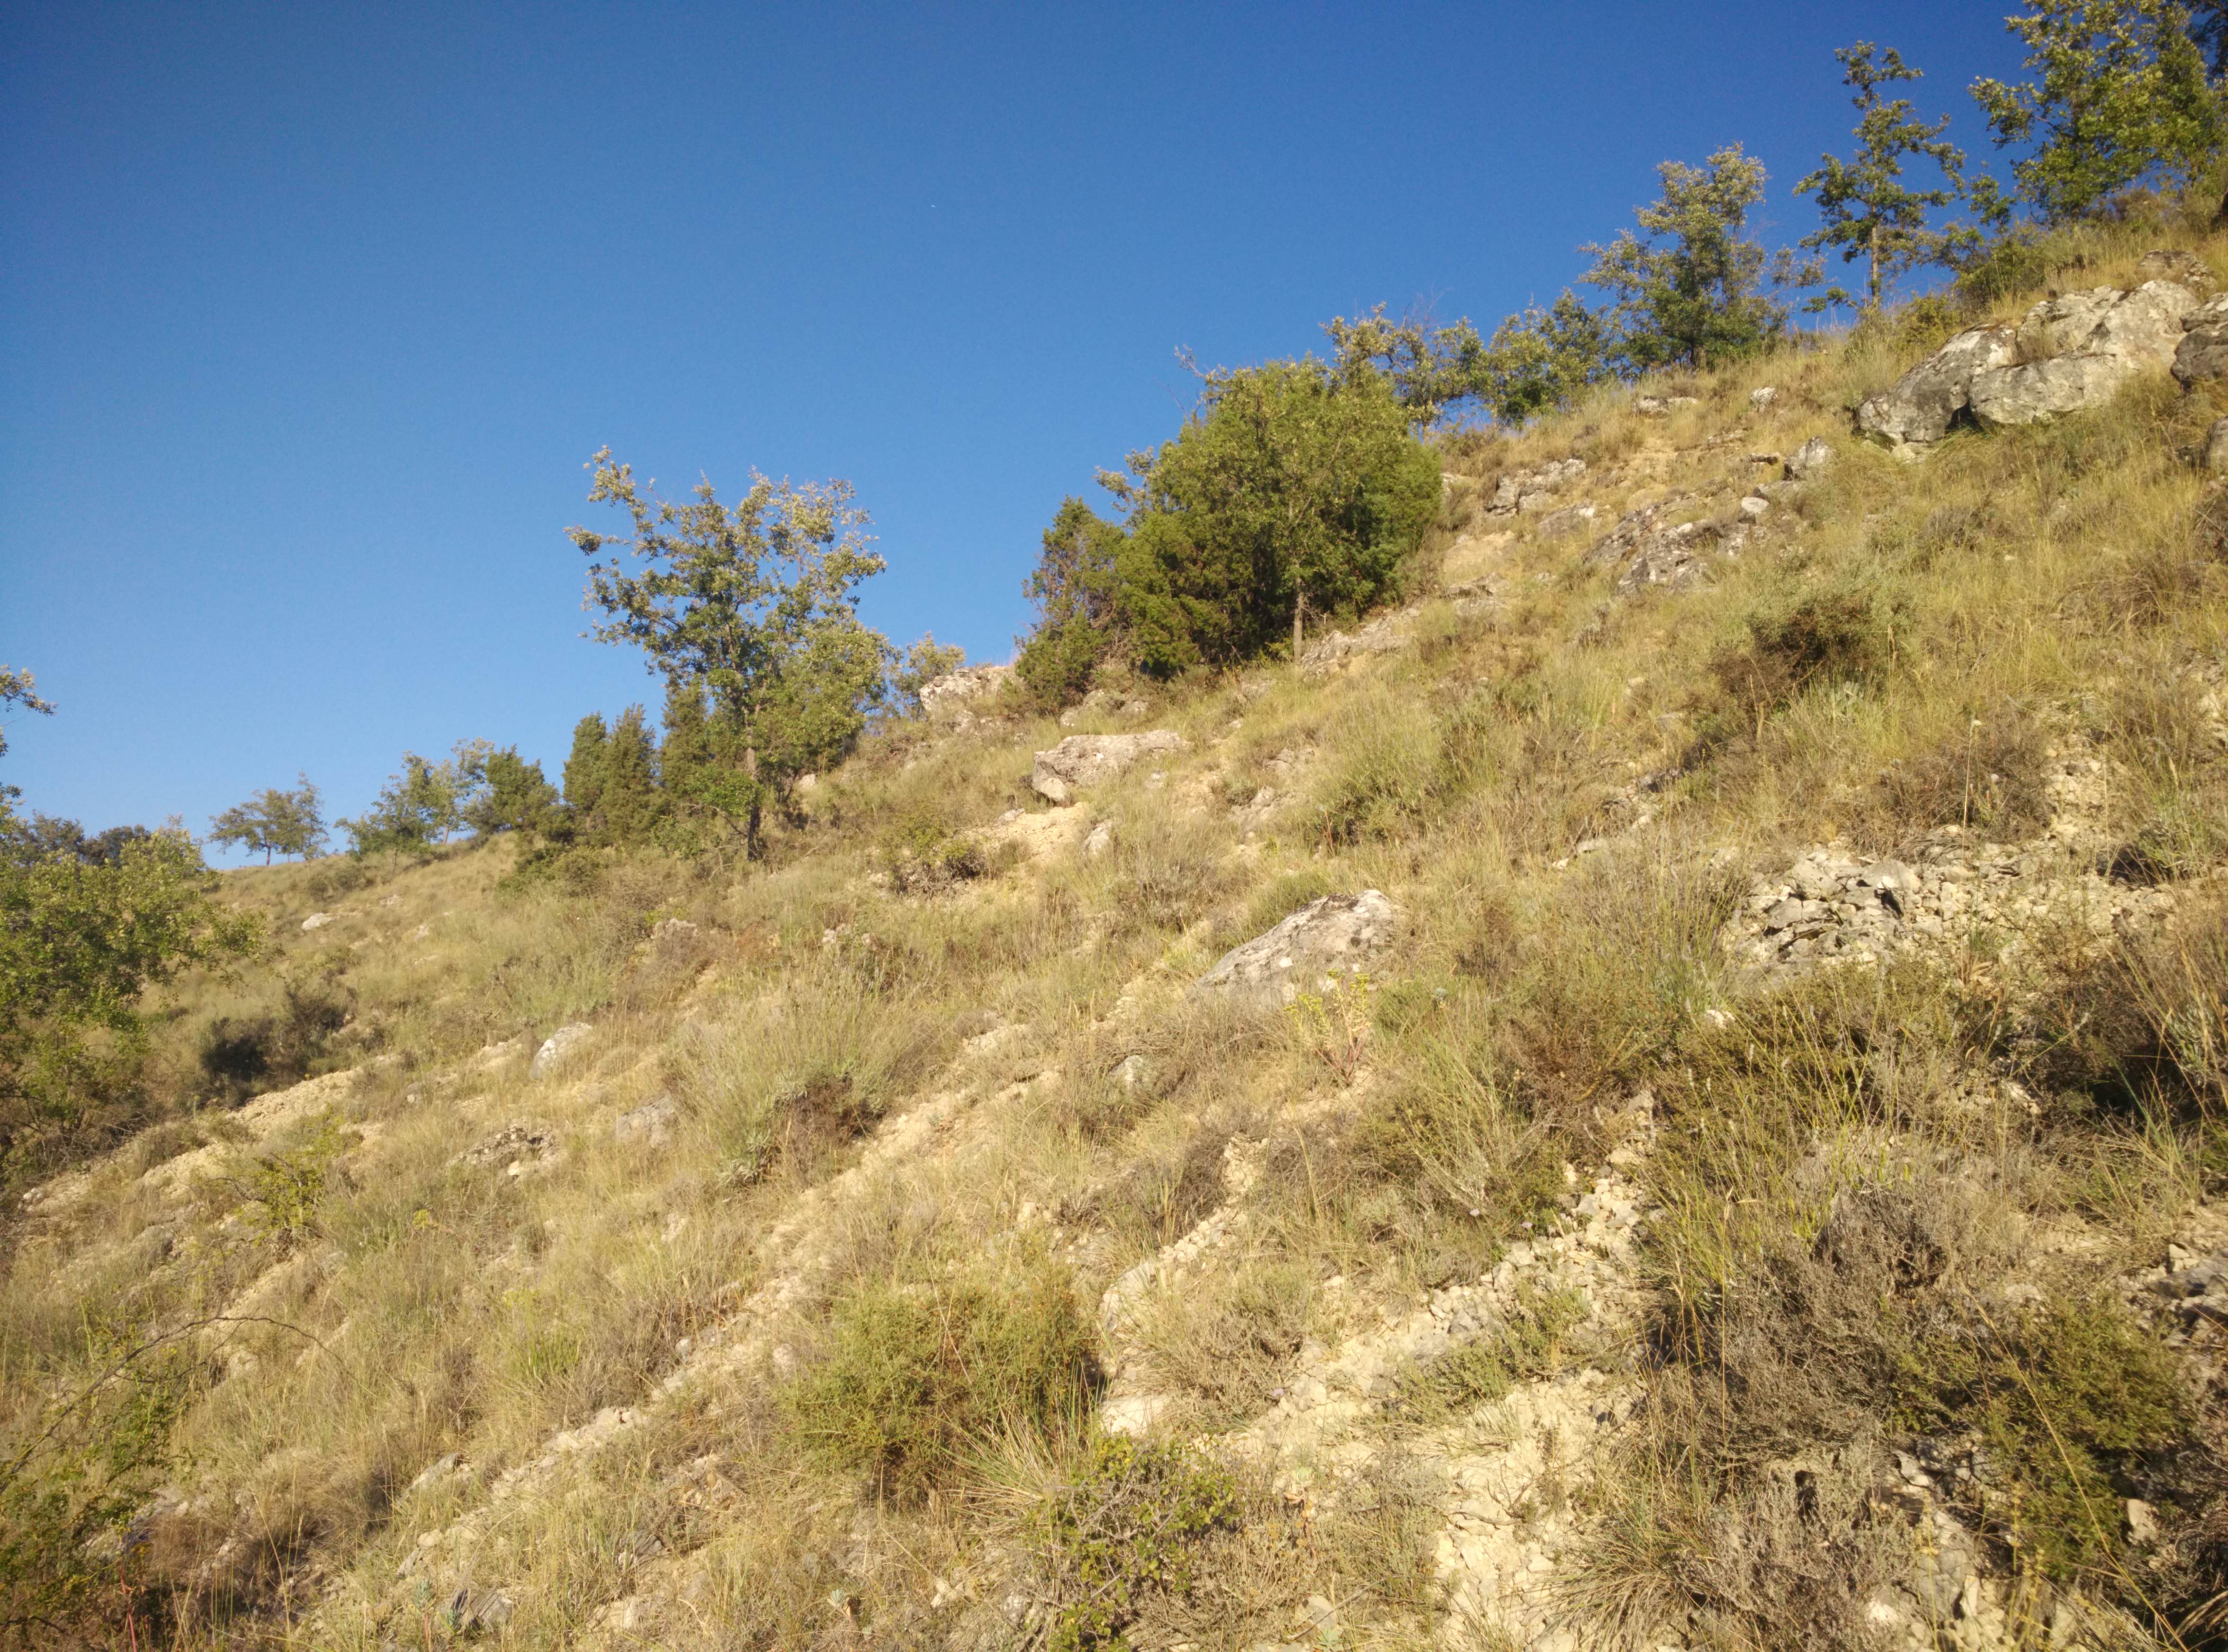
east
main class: Shrubland
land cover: Shrubland with sparse tree cover
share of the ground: 50 - 75 %
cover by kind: shrubs 50 %, unconsolidated bare surface 45 %, broadleaved forest trees 5 %
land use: Semi-natural and natural areas not in use
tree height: > 5 m
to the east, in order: Shrubland with sparse tree cover; Tracks; Shrubland with sparse tree cover
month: July
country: ES
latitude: 40.5776
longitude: -2.7987
